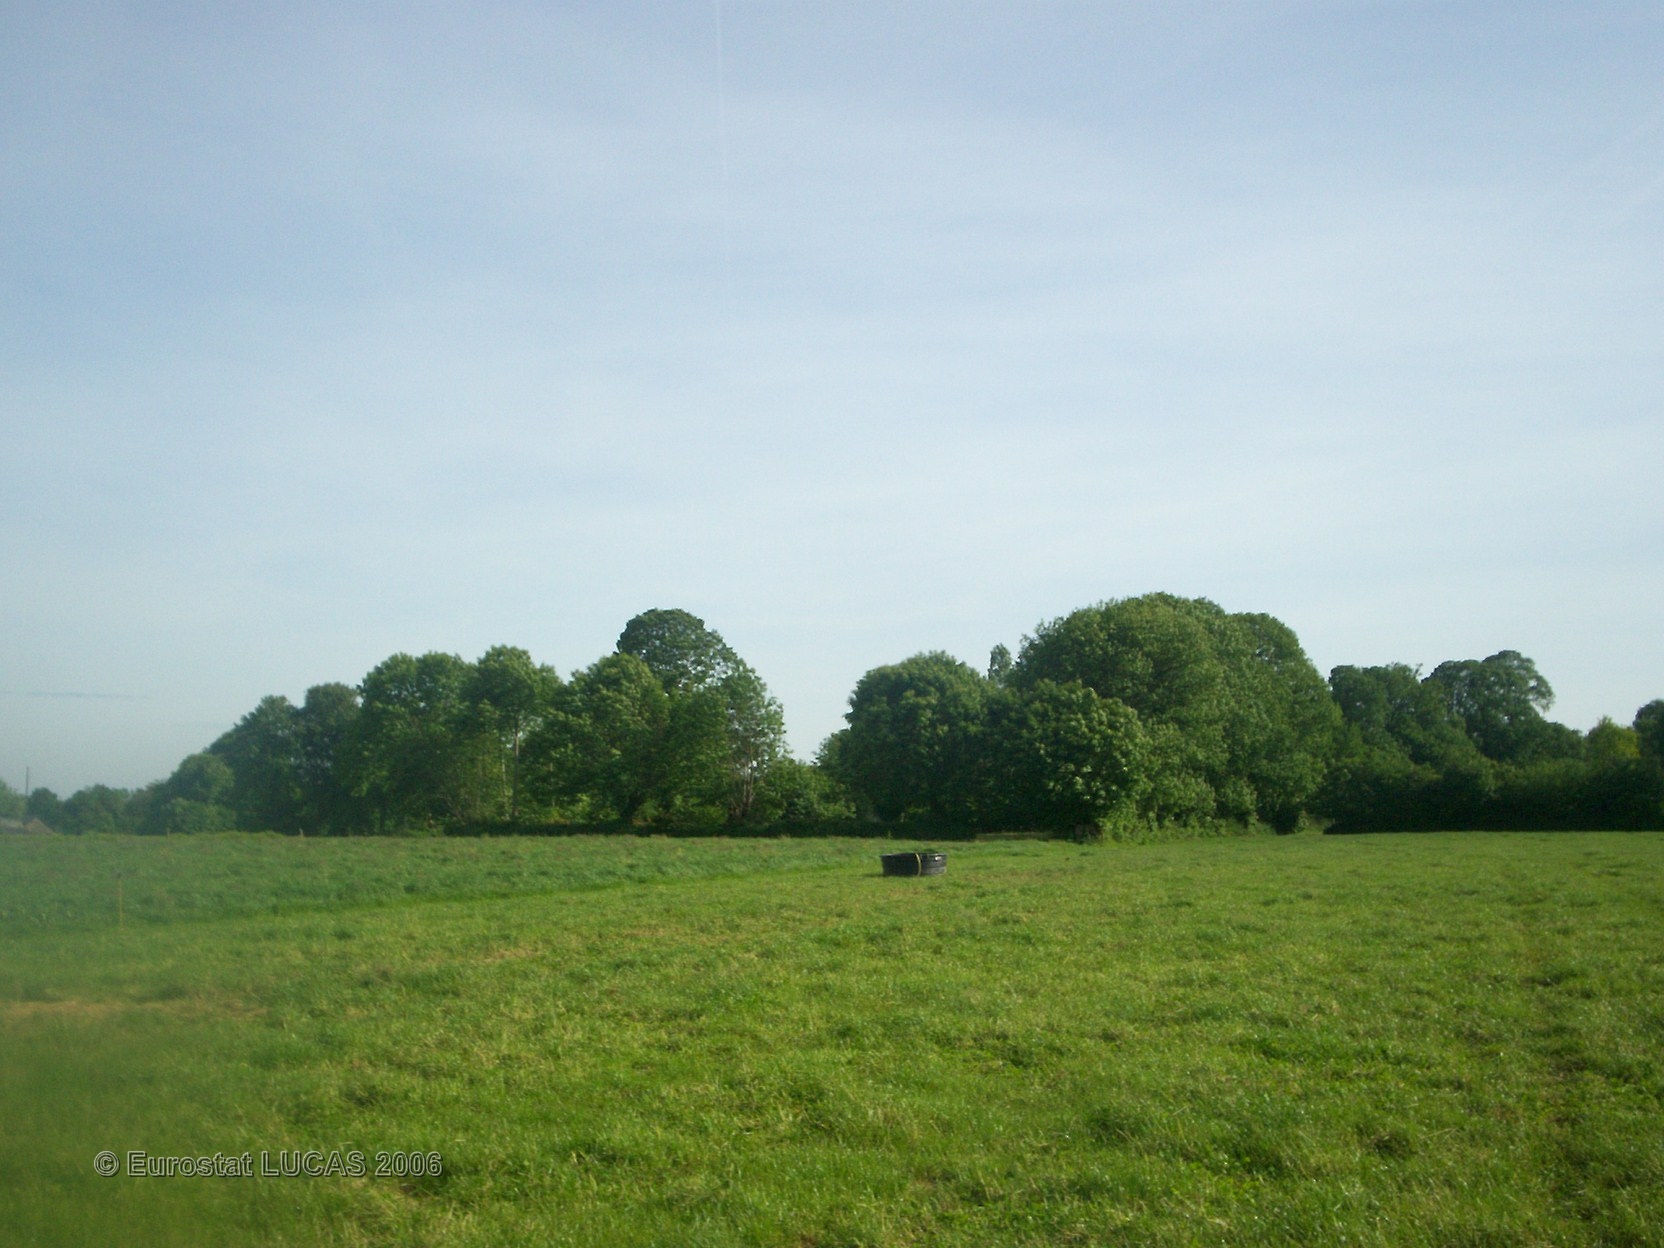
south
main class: Grassland
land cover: Grassland without tree/shrub cover
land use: Agriculture (excluding fallow land and kitchen gardens)
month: June
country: FR
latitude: 48.5364
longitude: -1.2442
